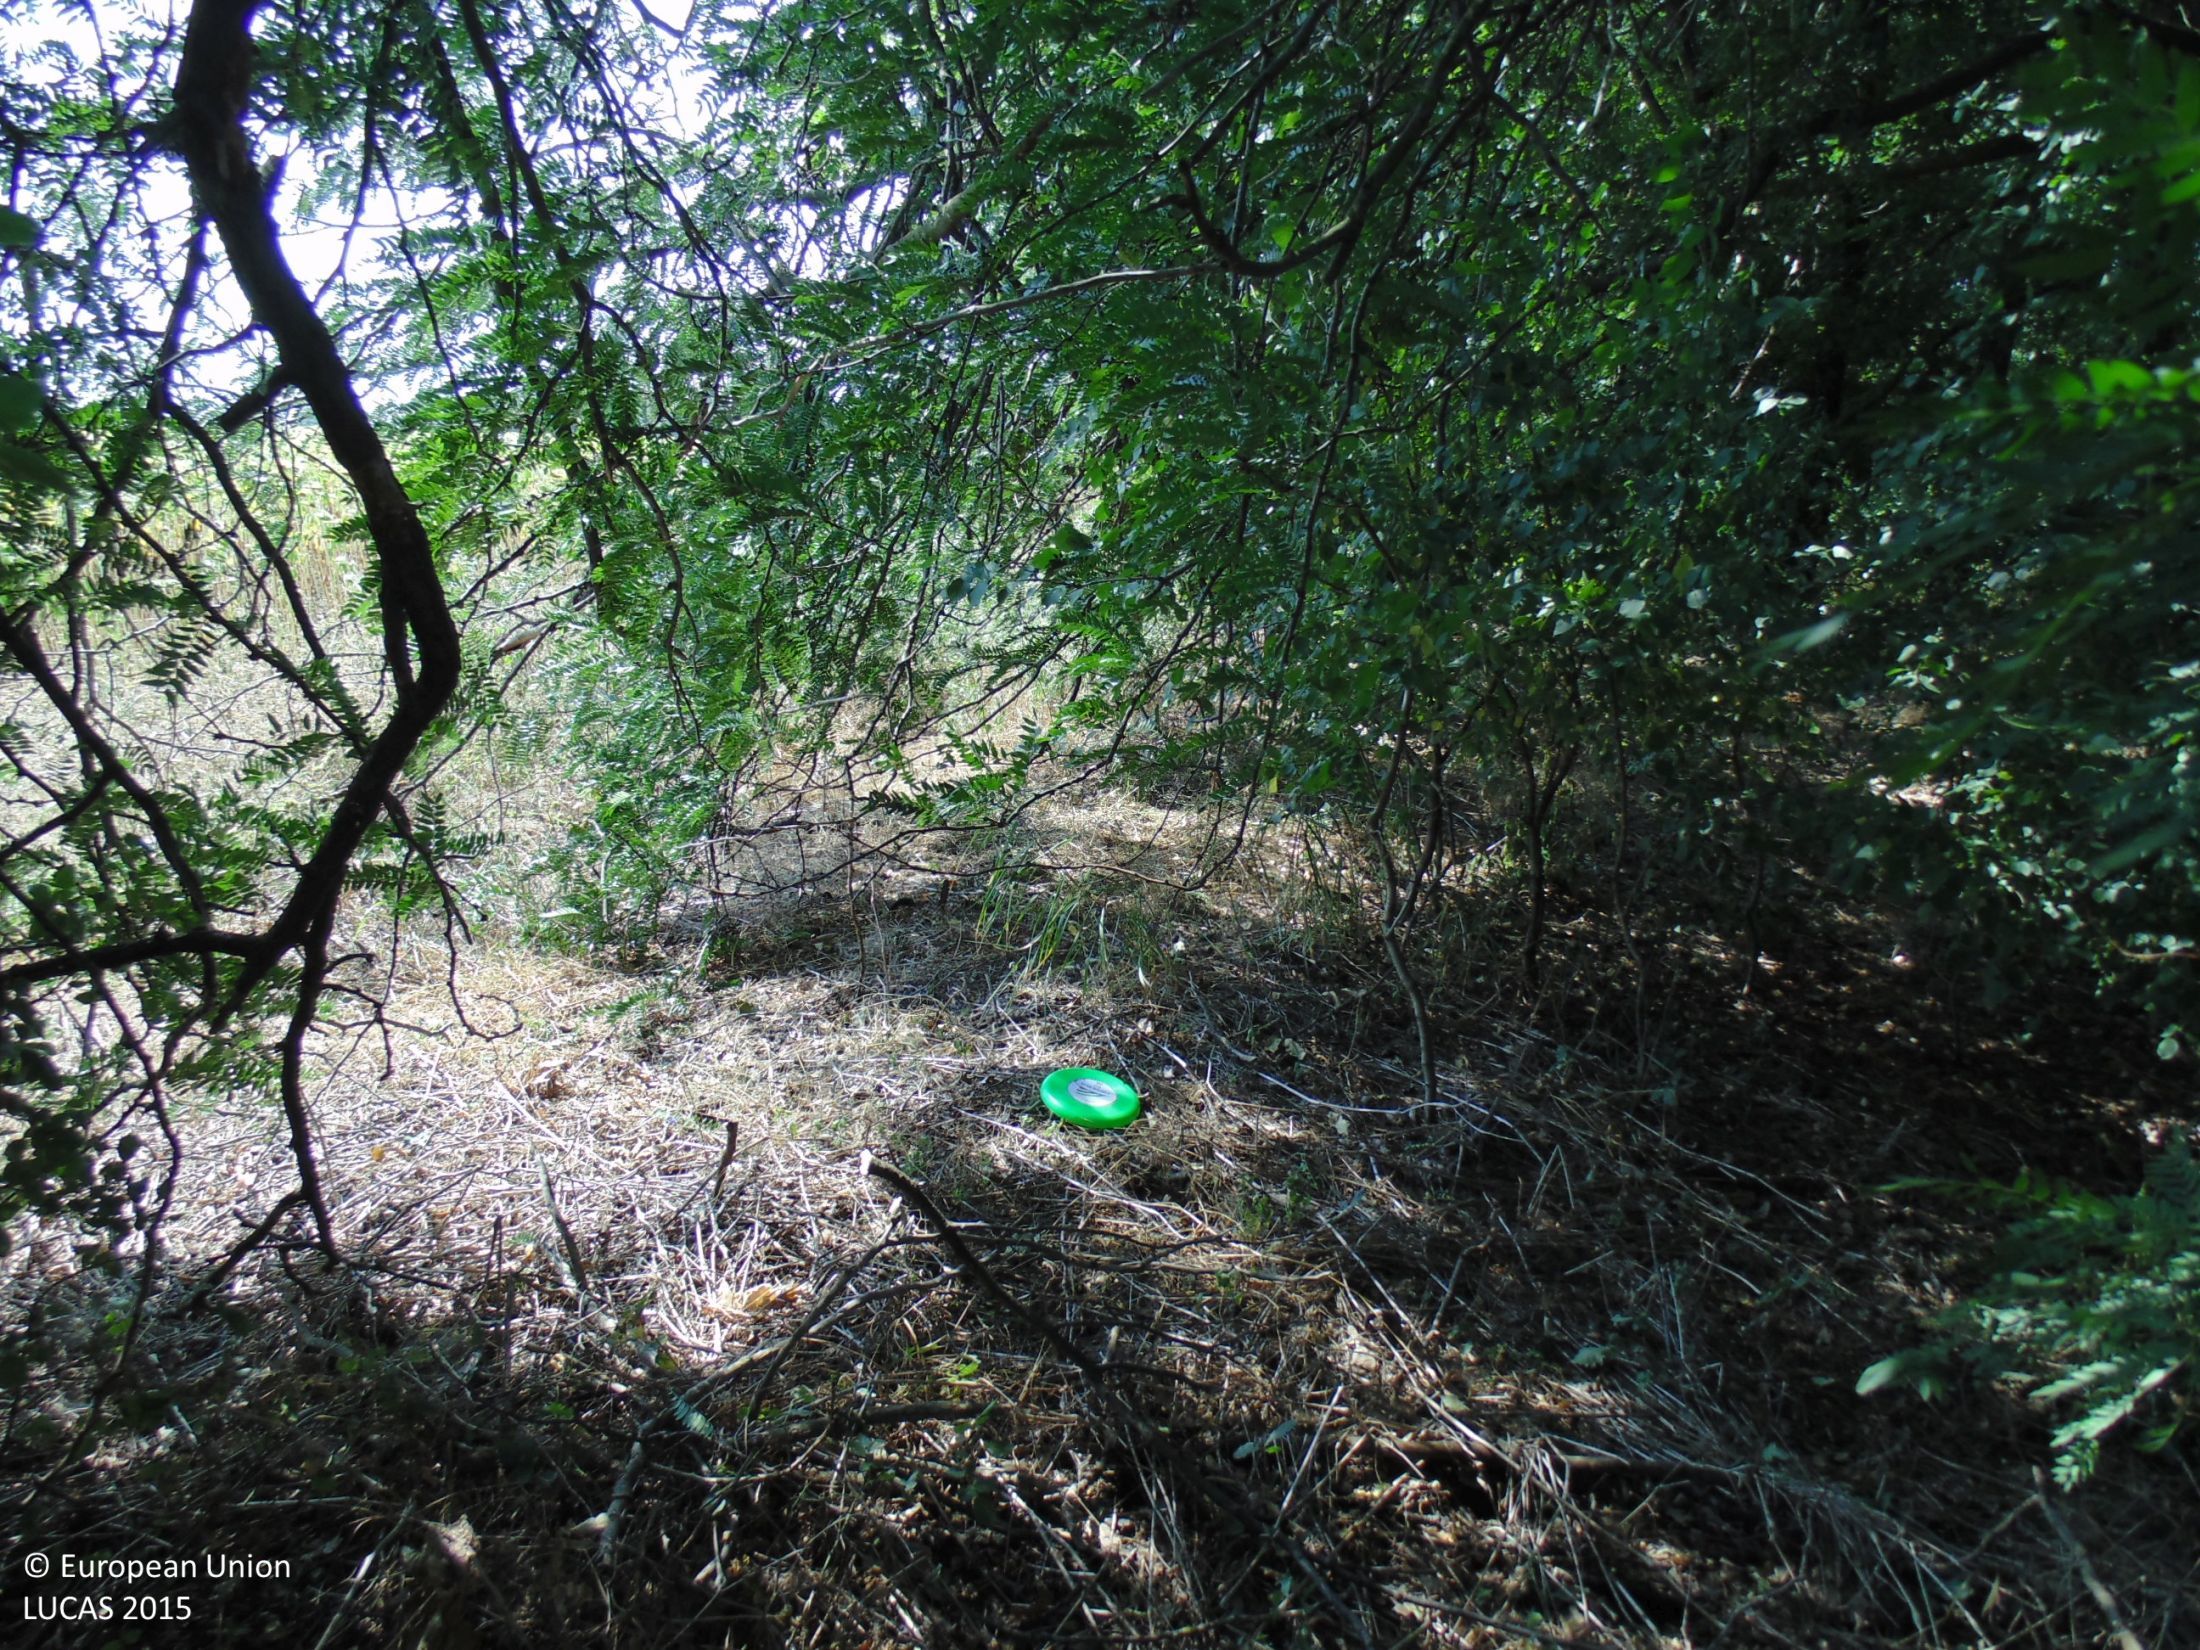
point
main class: Woodland
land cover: Broadleaved woodland
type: mesophytic deciduous forest
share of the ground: > 75 %
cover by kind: broadleaved forest trees 90 %, shrubs 5 %, unconsolidated bare surface 5 %
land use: Forestry
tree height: > 5 m
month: August
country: BG
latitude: 43.7469
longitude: 27.6352
